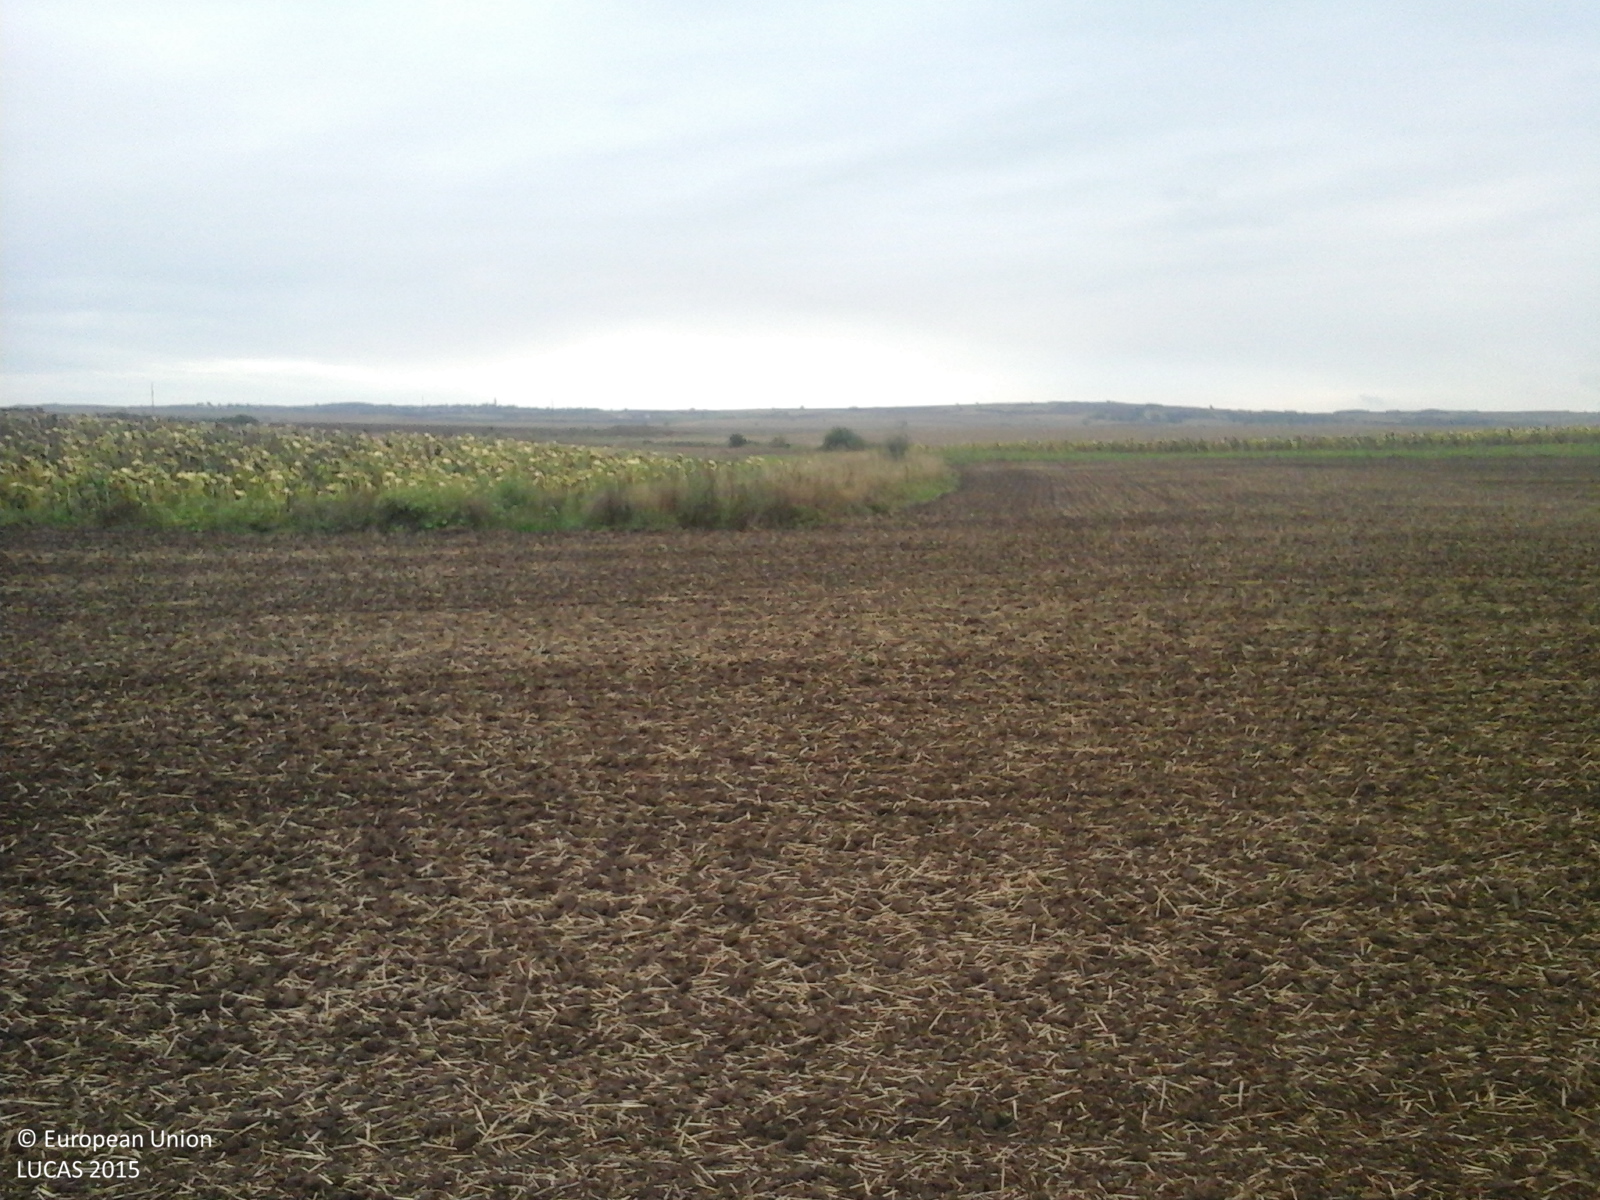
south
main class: Cropland
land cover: Common wheat
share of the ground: < 10 %
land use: Agriculture (excluding fallow land and kitchen gardens)
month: September
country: RO
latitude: 47.1843
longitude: 21.9907
